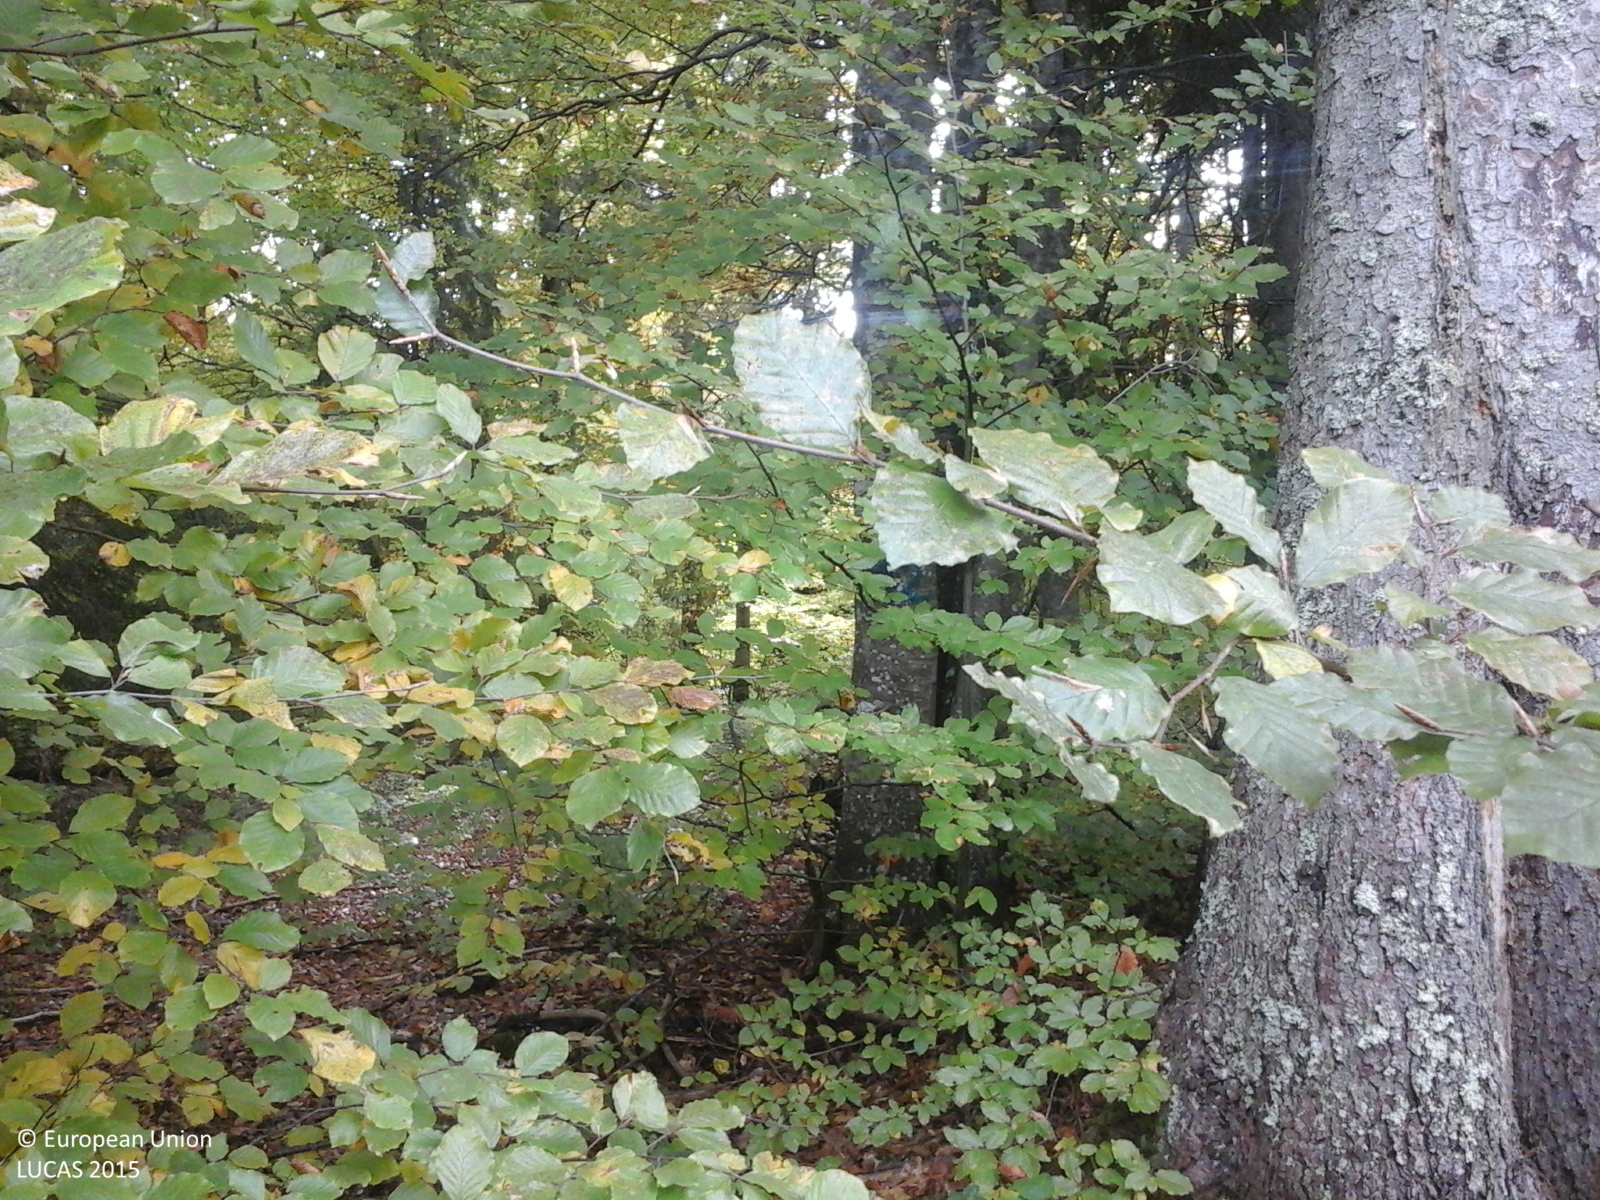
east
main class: Woodland
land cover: Other mixed woodland
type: alpine coniferous forest
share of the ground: > 75 %
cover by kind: coniferous forest trees 60 %, broadleaved forest trees 40 %
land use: Forestry
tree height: > 5 m
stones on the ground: 10 - 25 %
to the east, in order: Other mixed woodland
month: October
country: RO
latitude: 46.5507
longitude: 25.2455
